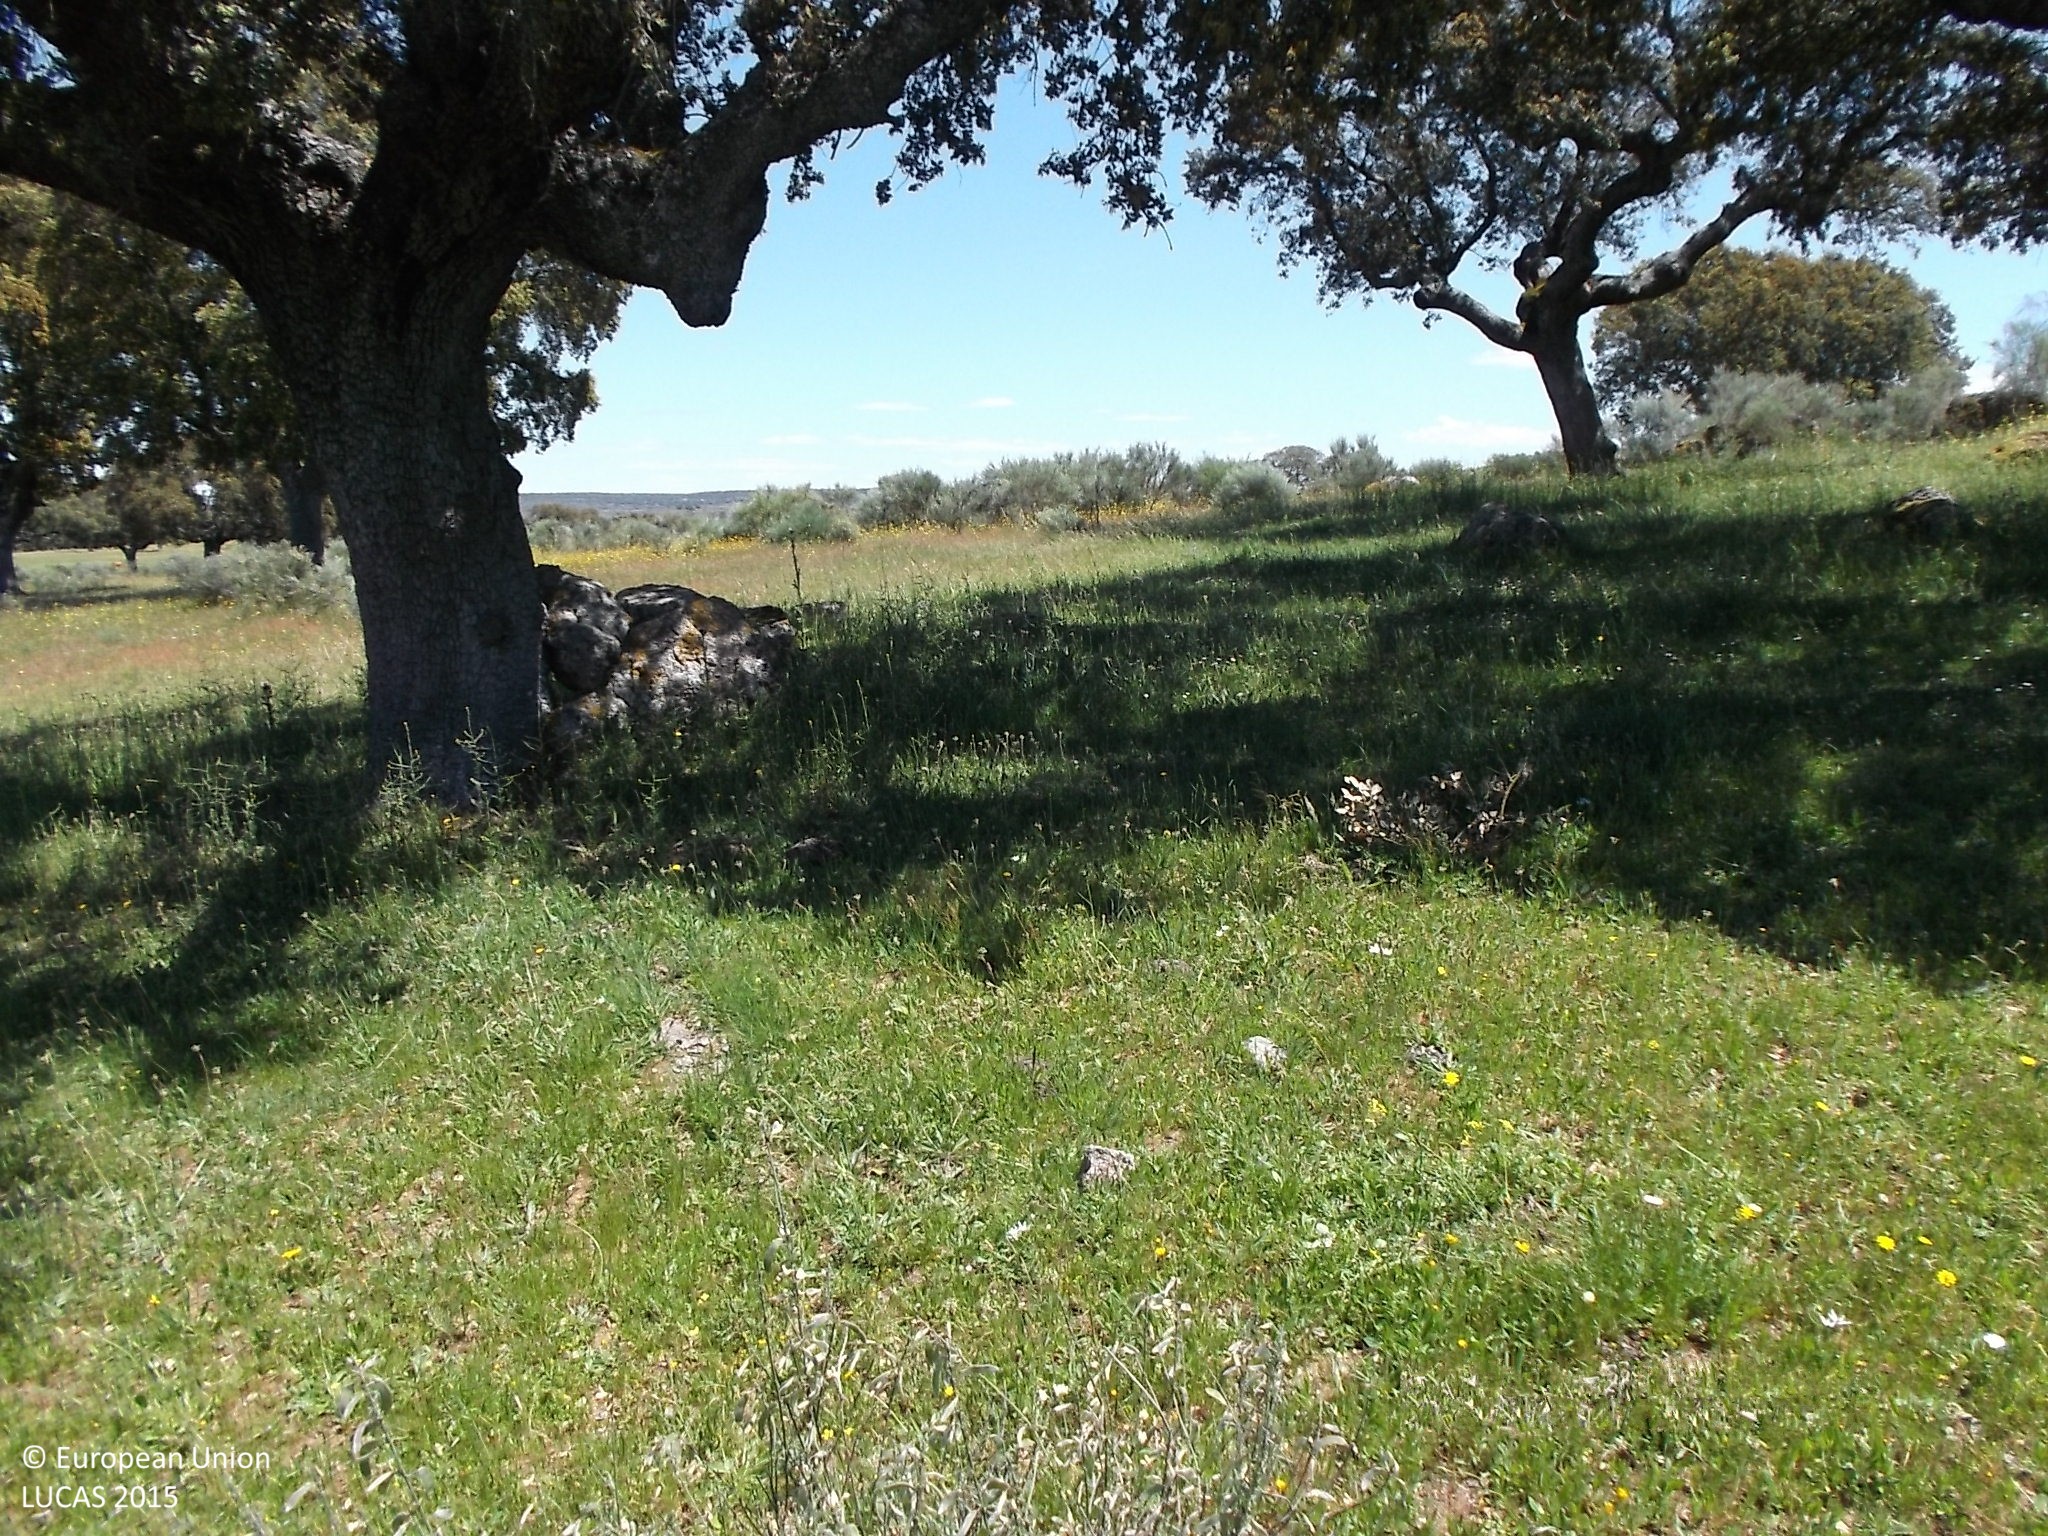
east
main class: Woodland
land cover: Broadleaved woodland
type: broadleaved evergreen forest
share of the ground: 10 - 25 %
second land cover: Grassland without tree/shrub cover
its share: > 75 %
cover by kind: herbaceous plants 70 %, broadleaved forest trees 20 %, shrubs 10 %
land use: Forestry
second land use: Agriculture (excluding fallow land and kitchen gardens)
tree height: > 5 m
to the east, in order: Broadleaved woodland; Grassland without tree/shrub cover
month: May
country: ES
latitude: 40.9091
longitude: -6.2464
